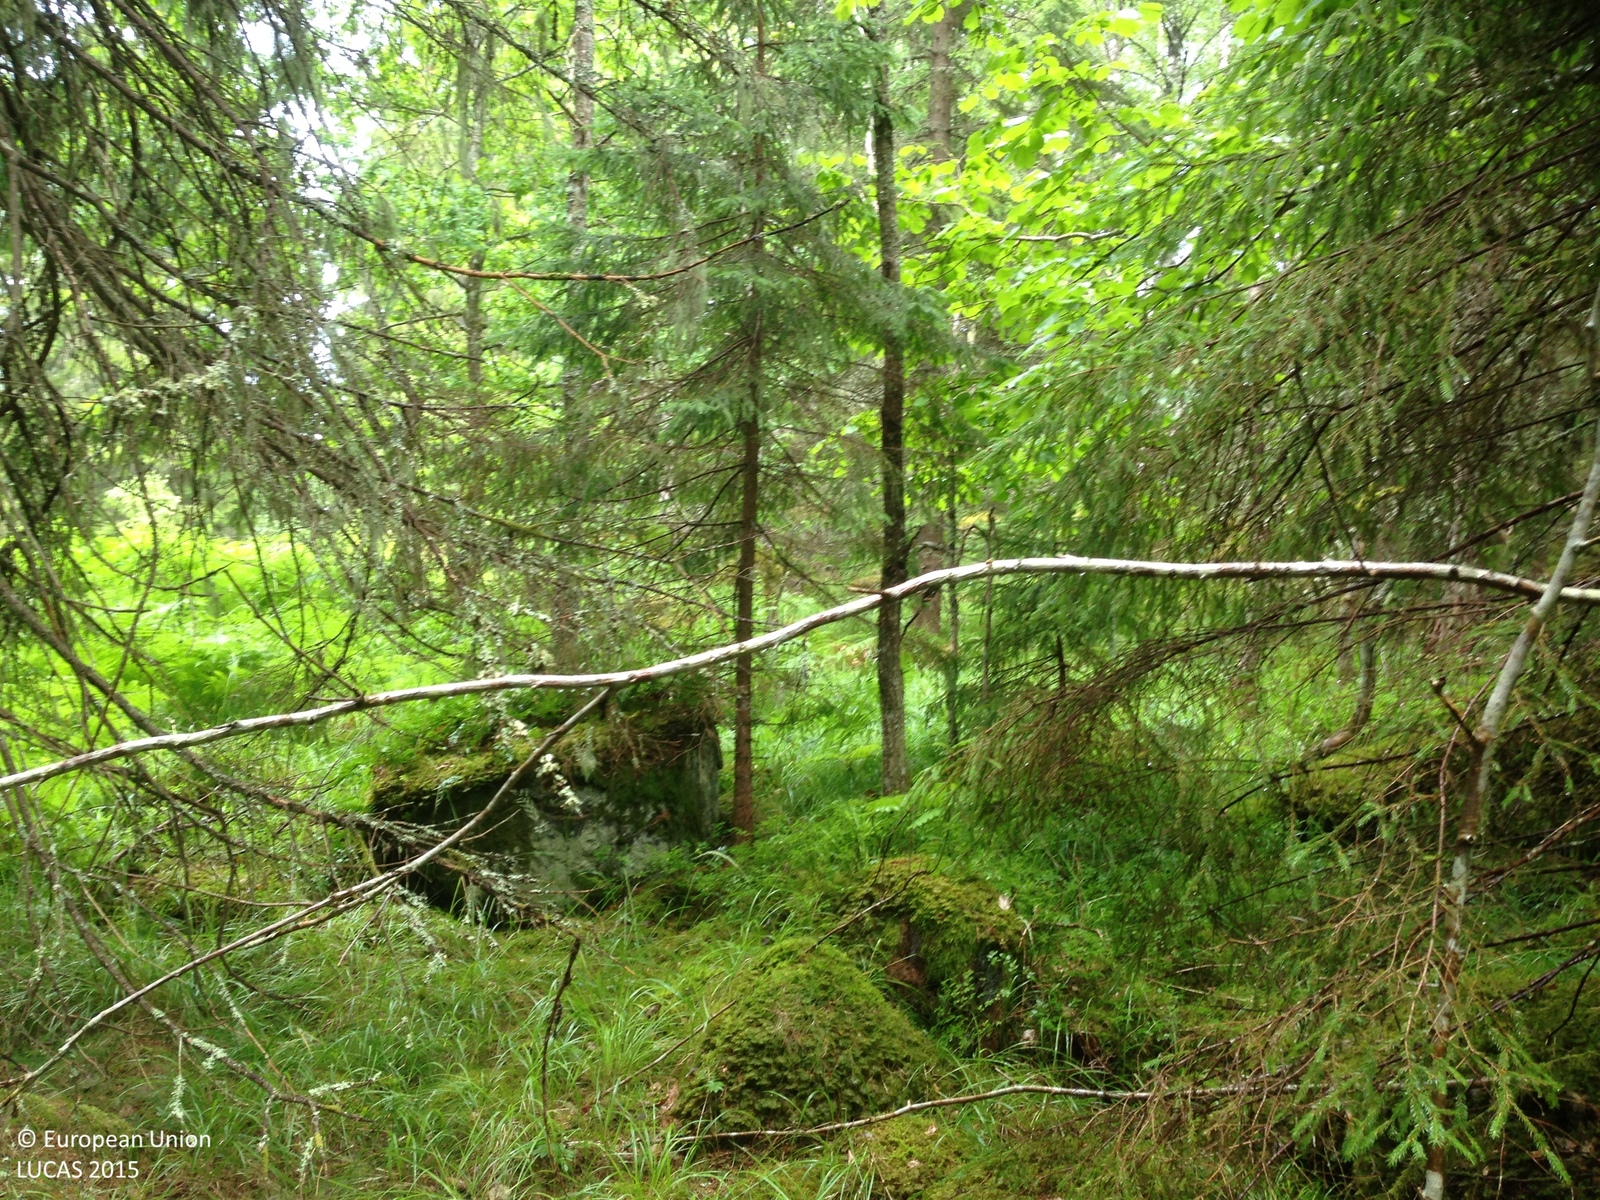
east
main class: Woodland
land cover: Spruce dominated coniferous woodland
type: boreal forest
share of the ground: > 75 %
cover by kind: coniferous forest trees 75 %, lichens and mosses 15 %, broadleaved forest trees 10 %
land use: Forestry
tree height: > 5 m
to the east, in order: Spruce dominated coniferous woodland; Artificial constructions in urban areas; Spruce dominated coniferous woodland; Fences; Grassland without tree/shrub cover; Fences; Spruce dominated coniferous woodland; Tracks
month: July
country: SE
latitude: 59.9334
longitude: 18.6416
